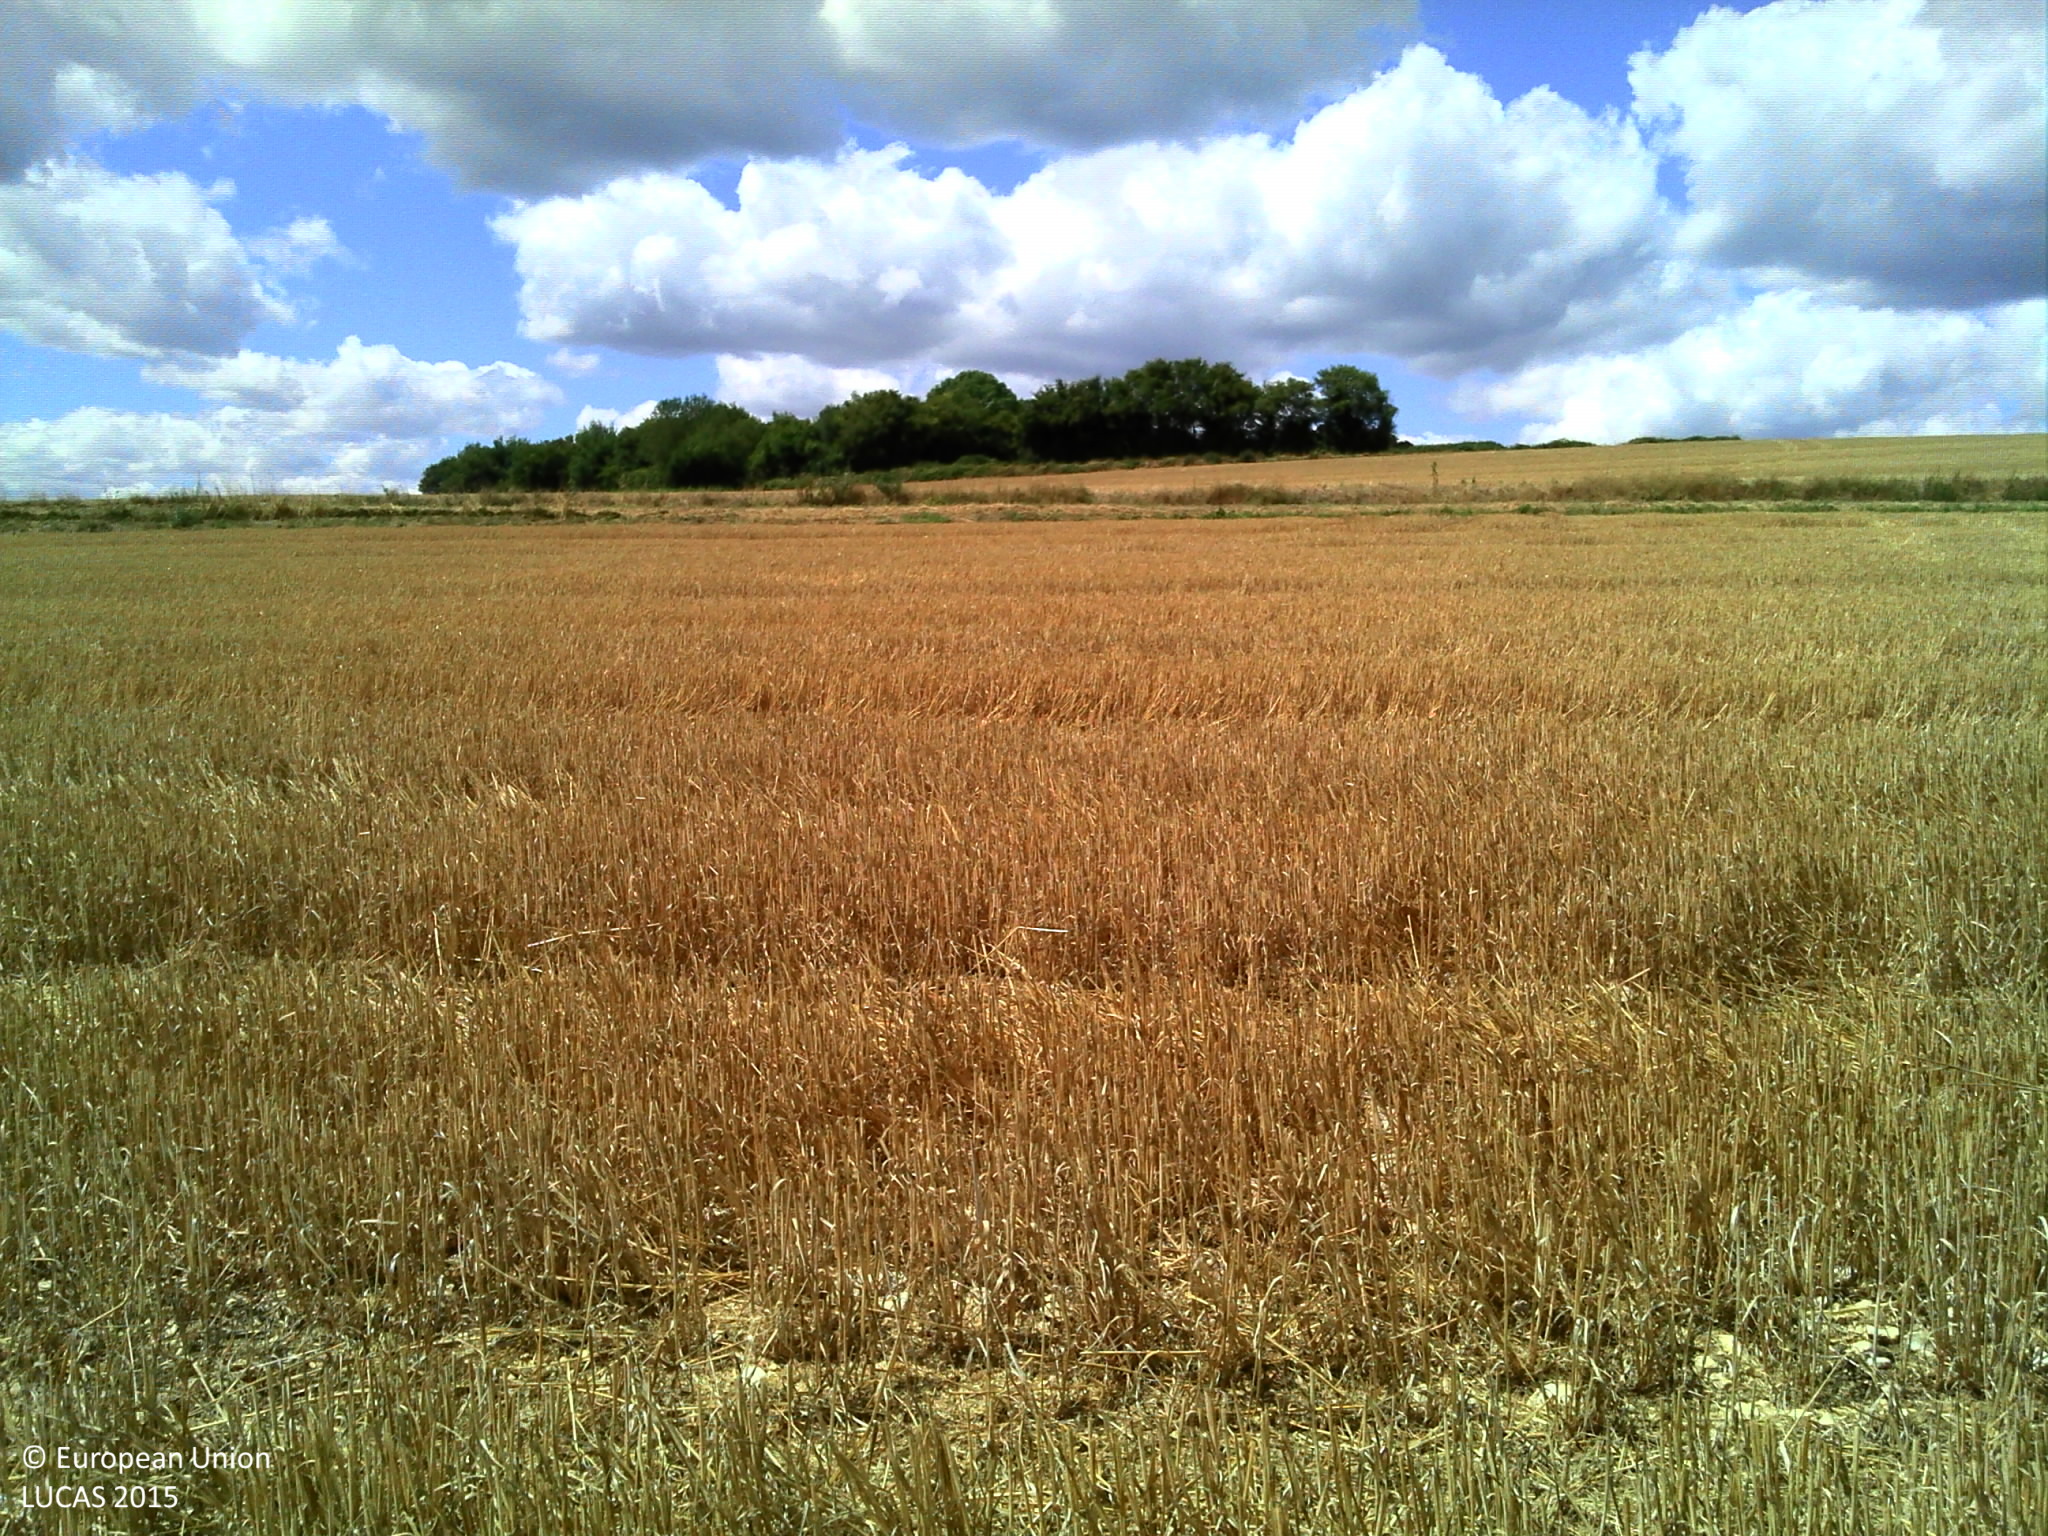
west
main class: Cropland
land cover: Common wheat
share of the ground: > 75 %
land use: Agriculture (excluding fallow land and kitchen gardens)
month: July
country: FR
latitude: 47.5427
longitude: 3.1792
